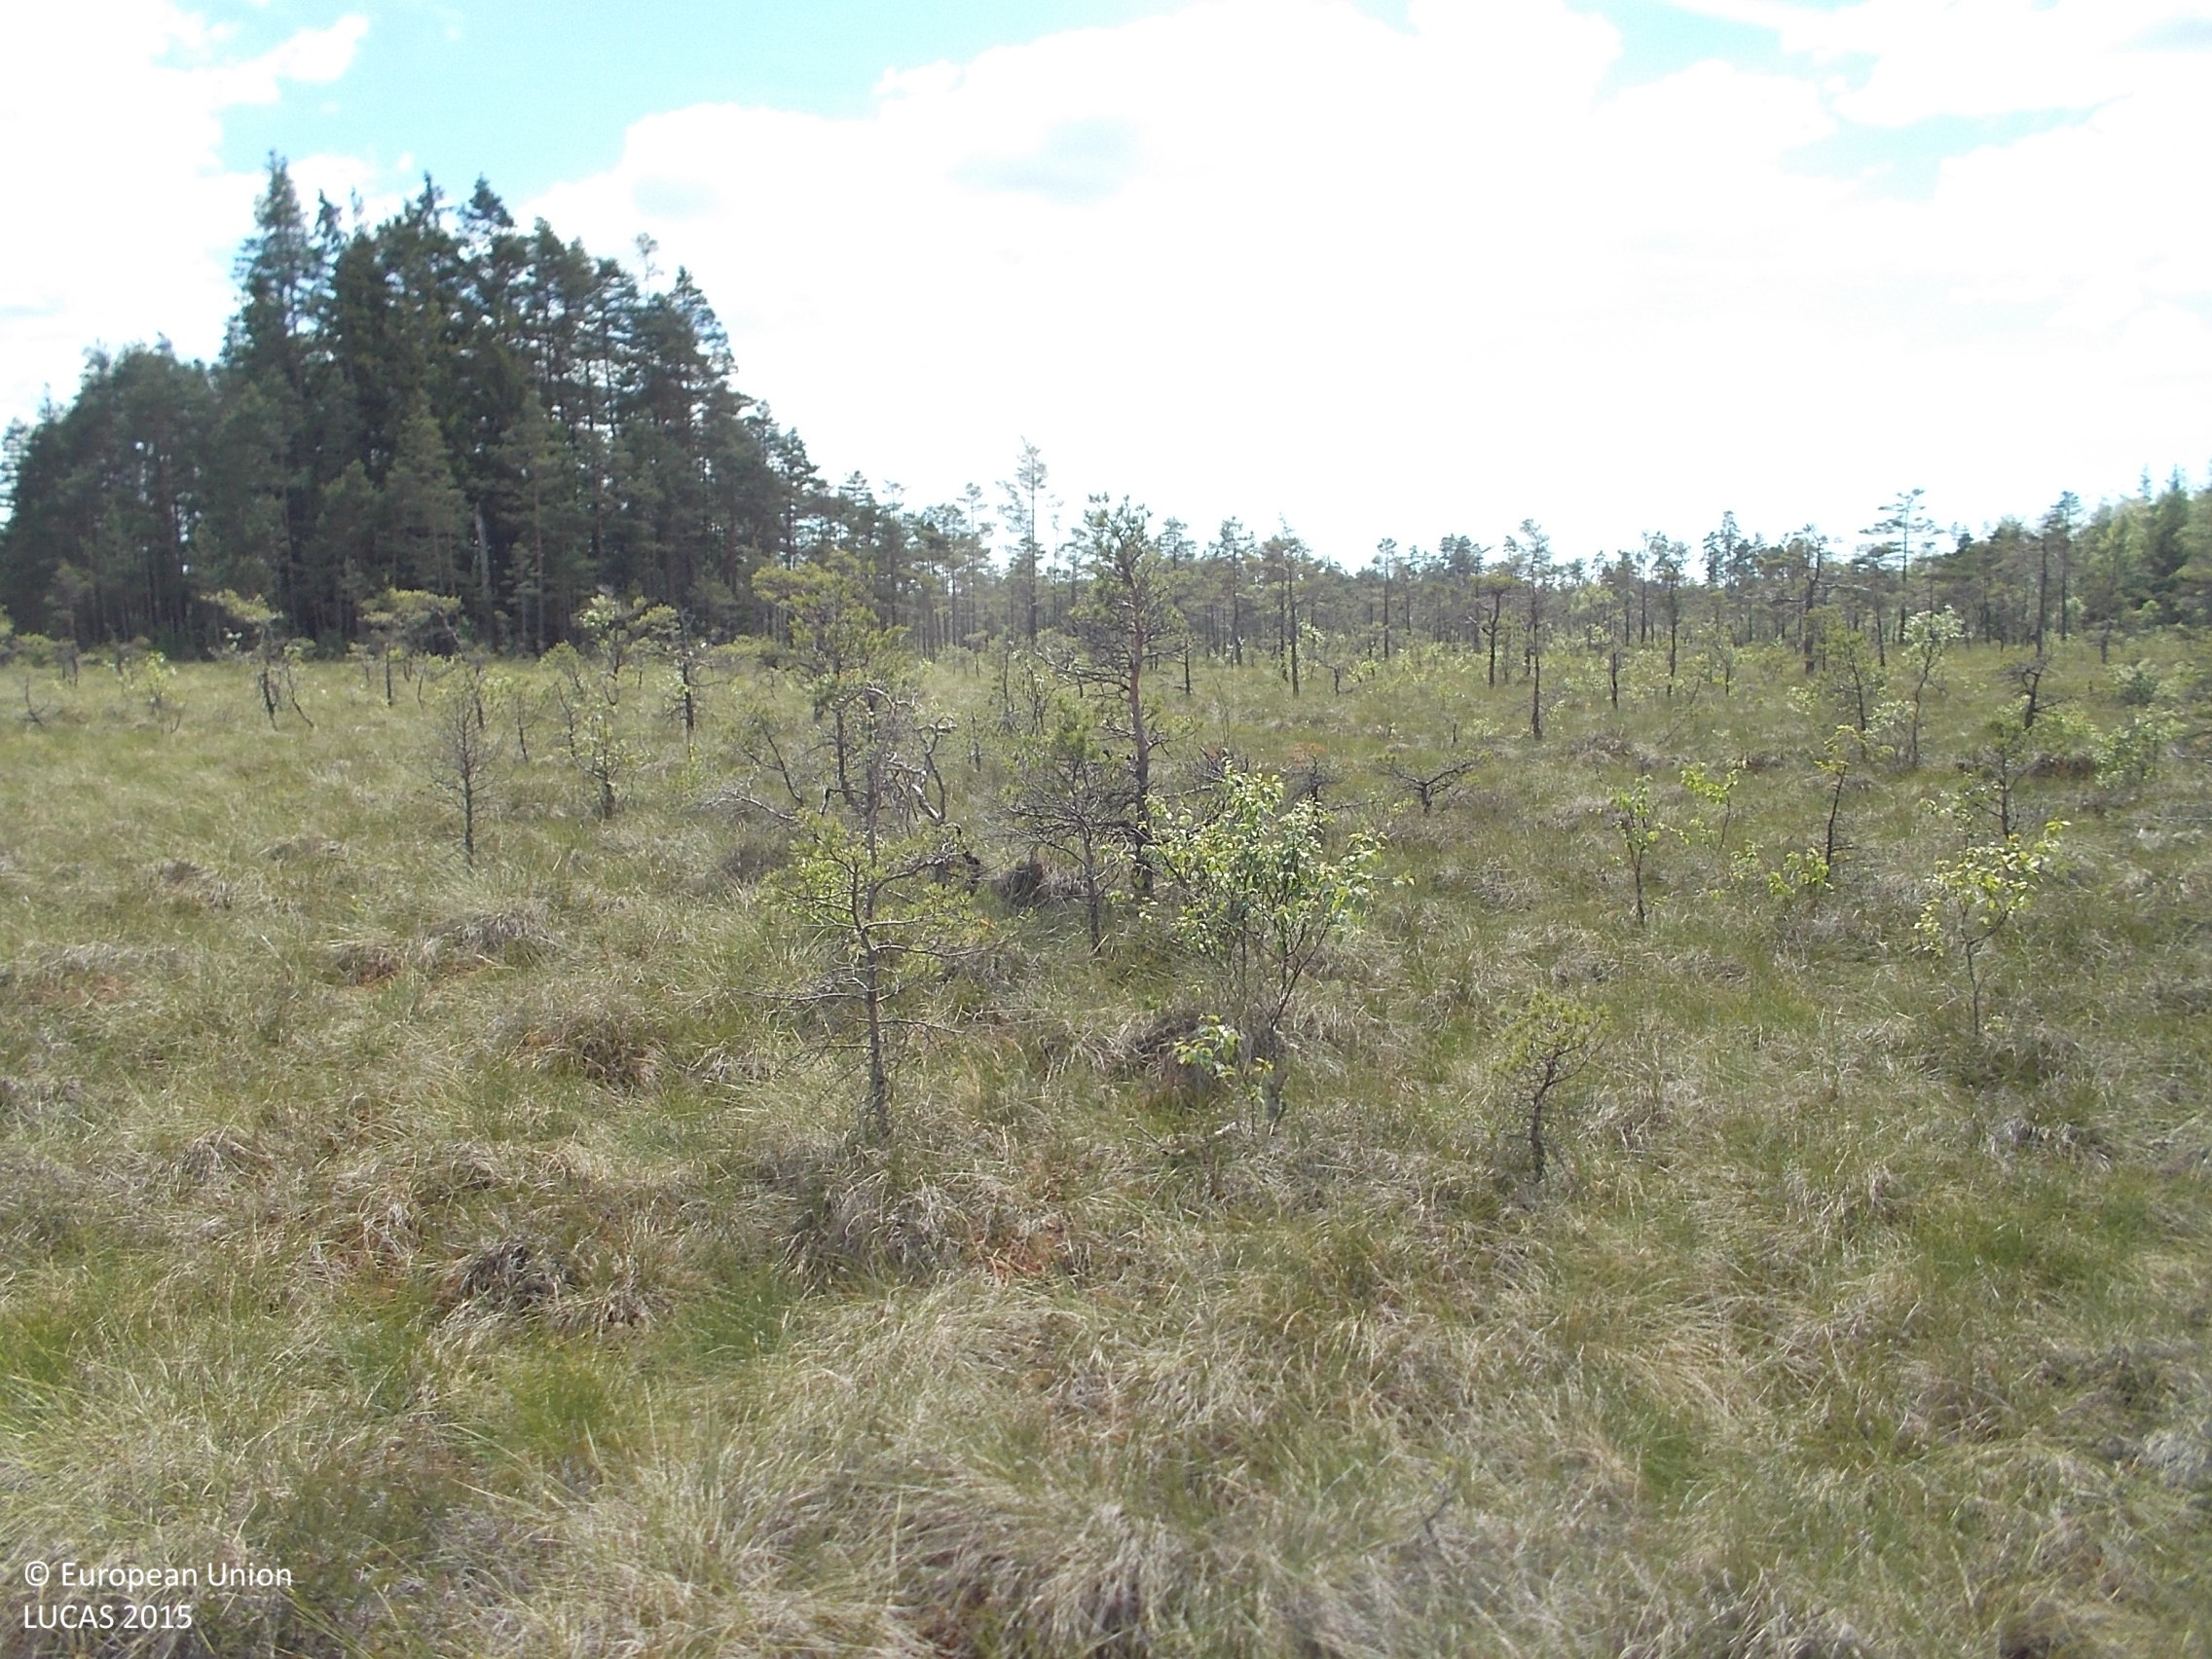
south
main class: Shrubland
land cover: Shrubland with sparse tree cover
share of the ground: 50 - 75 %
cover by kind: shrubs 50 %, herbaceous plants 45 %, coniferous forest trees 5 %
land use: Semi-natural and natural areas not in use
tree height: < 5 m
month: June
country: SE
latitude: 57.2855
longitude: 13.0320
